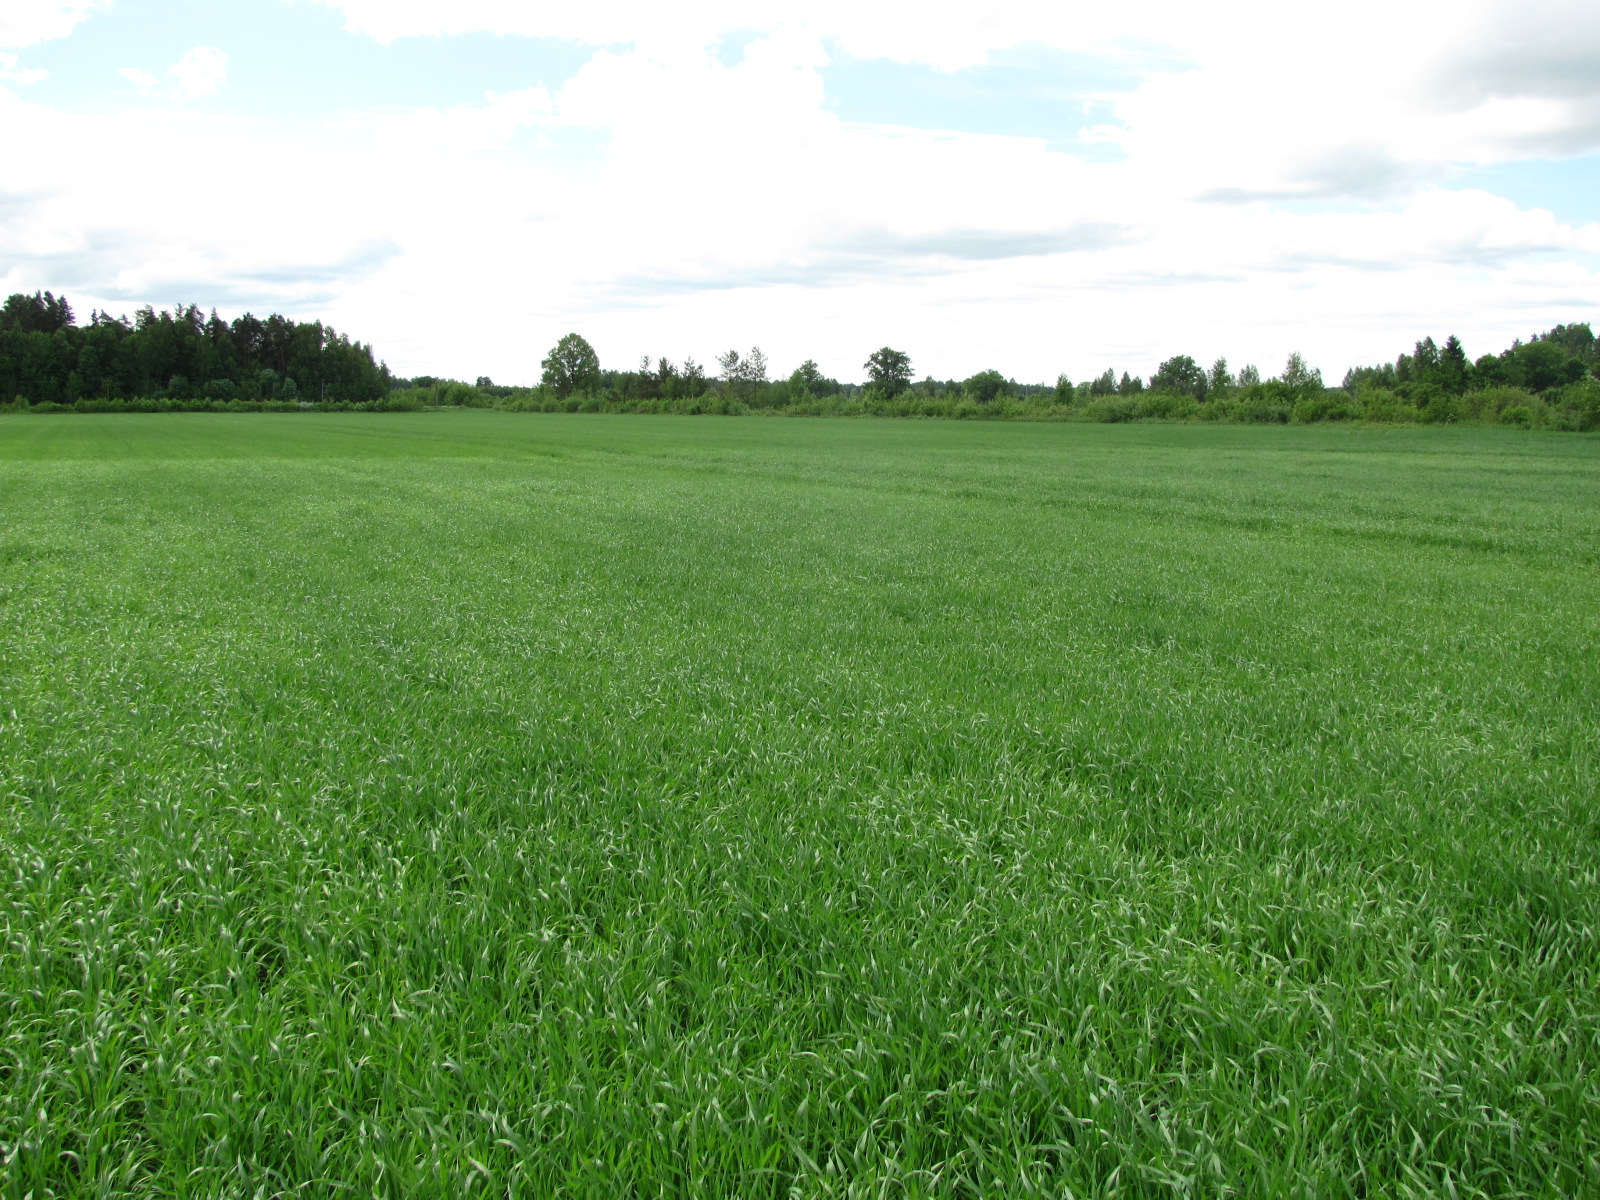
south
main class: Cropland
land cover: Common wheat
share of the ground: > 75 %
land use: Agriculture (excluding fallow land and kitchen gardens)
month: June
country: LV
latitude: 56.6899
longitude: 23.8781
